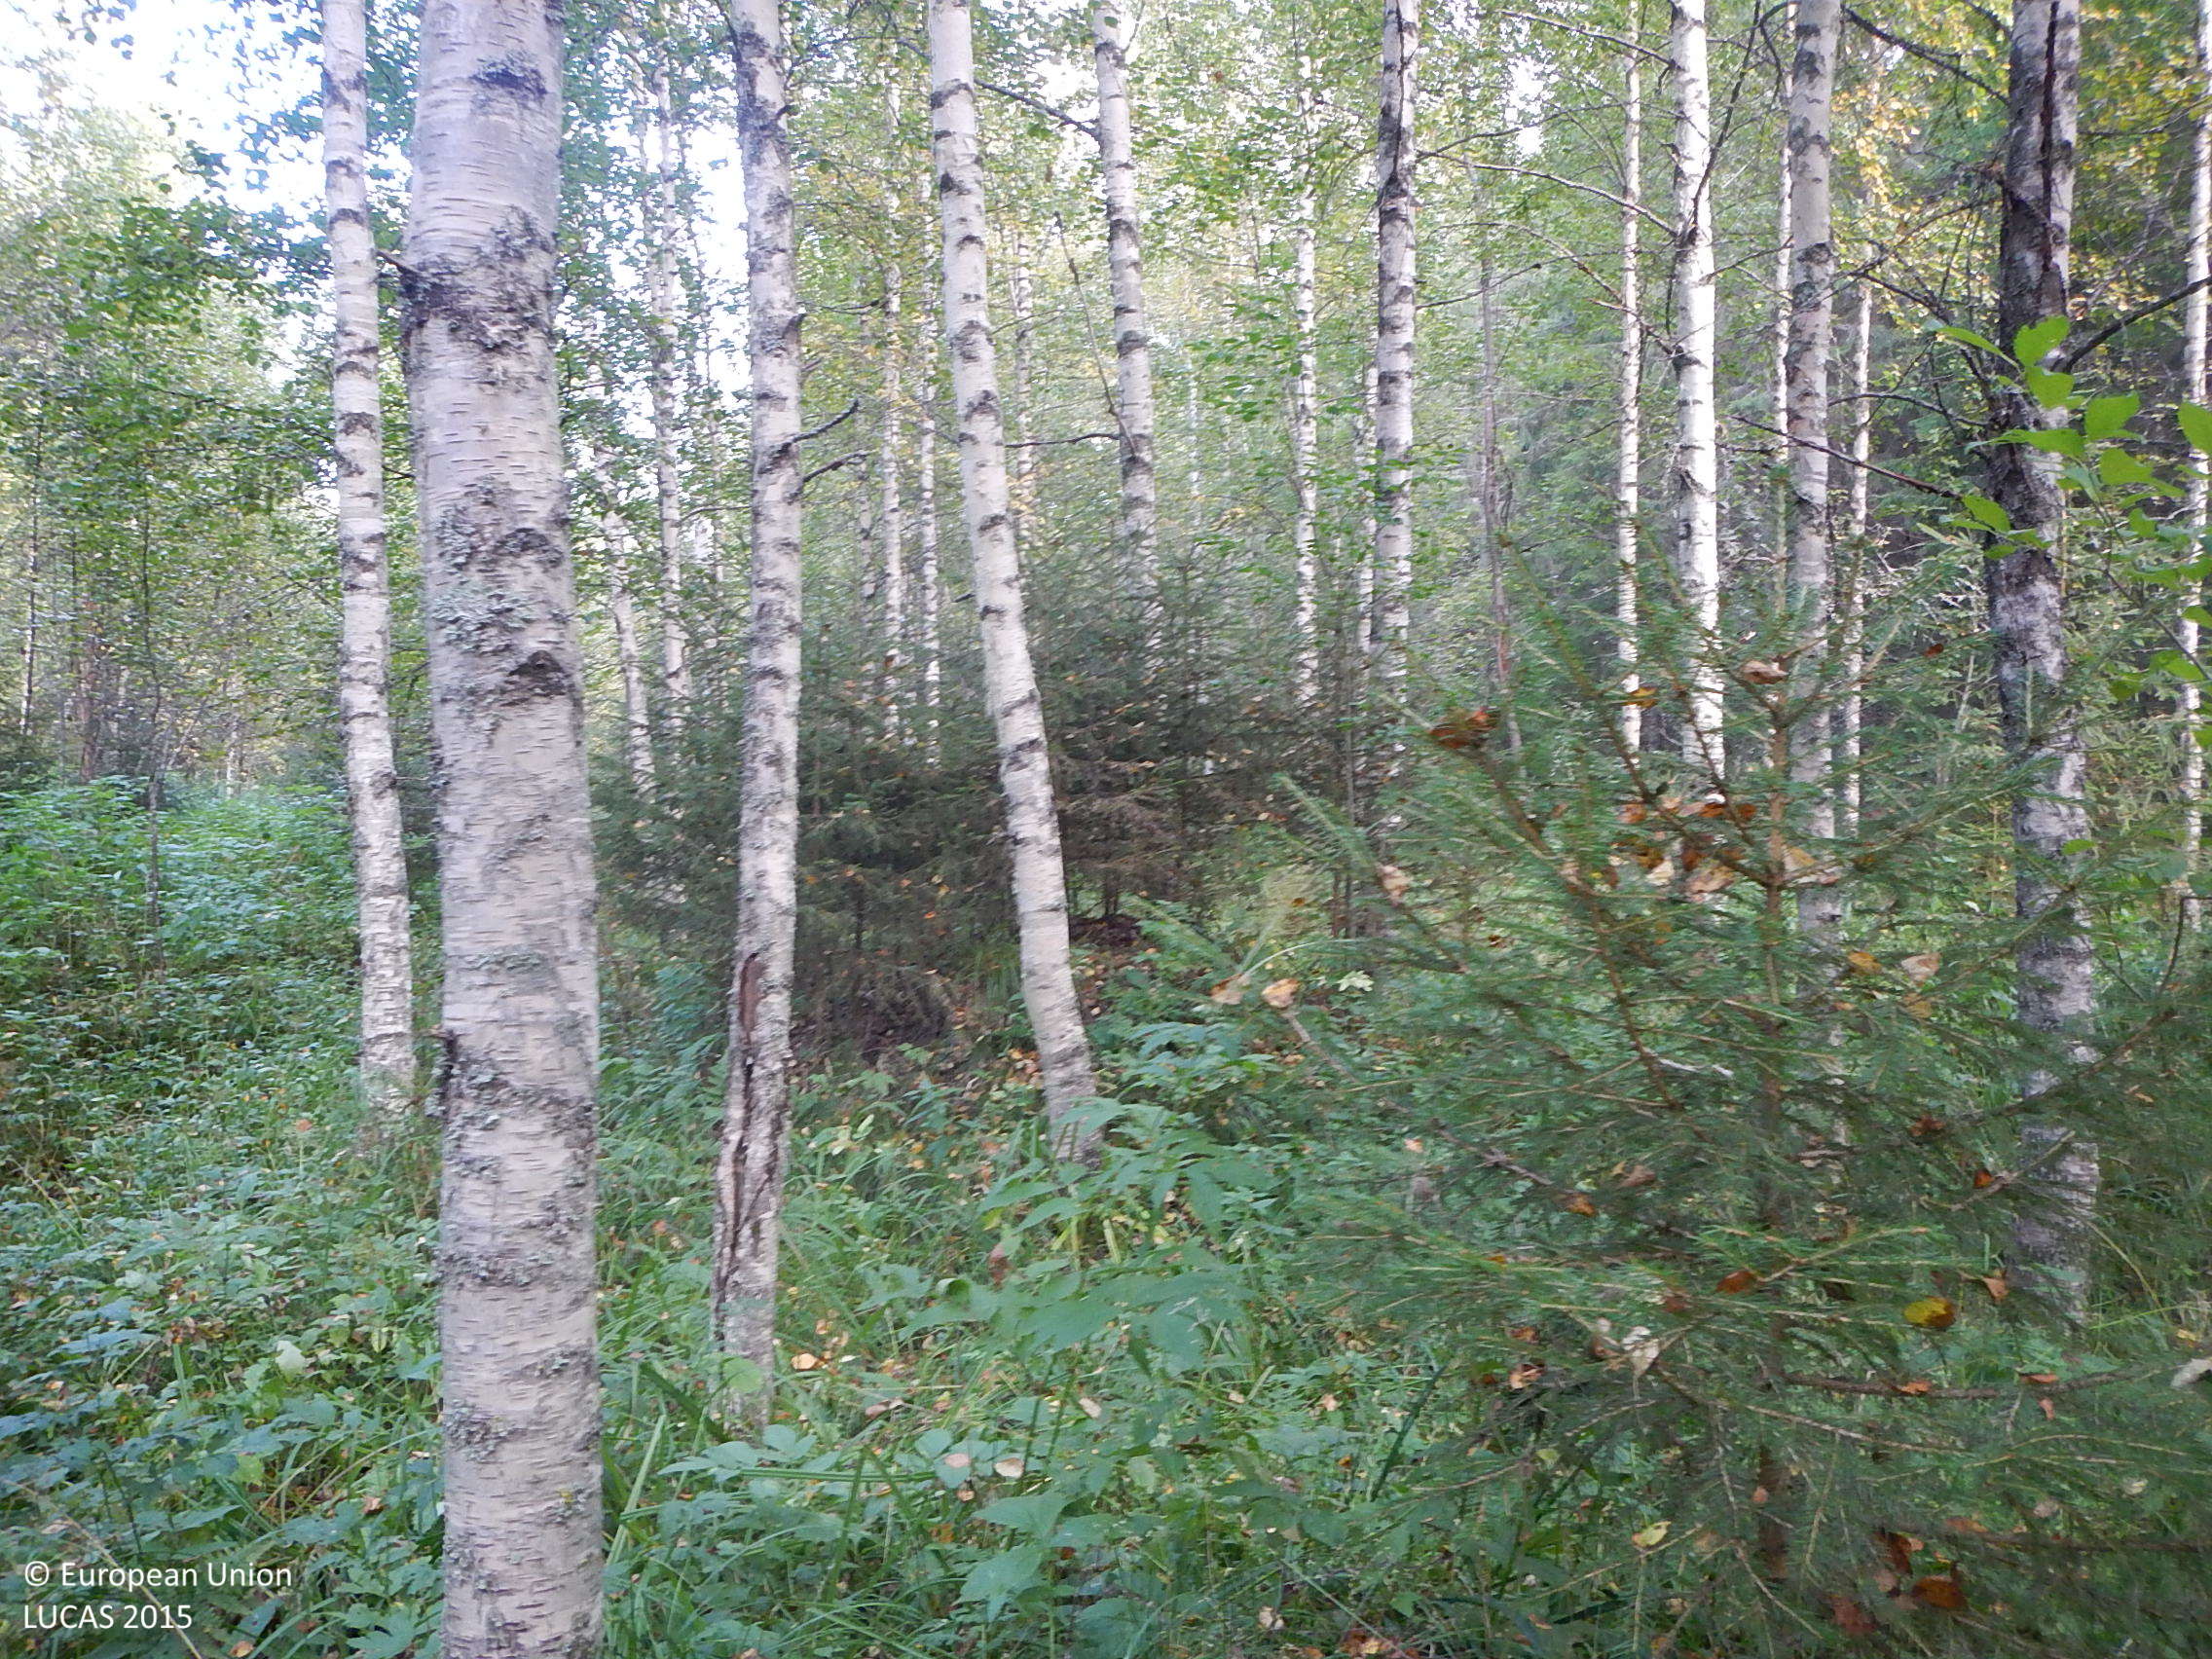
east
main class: Woodland
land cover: Broadleaved woodland
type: non-riverine alder, birch or aspen forest
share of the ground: > 75 %
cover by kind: broadleaved forest trees 75 %, herbaceous plants 20 %, shrubs 5 %
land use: Forestry
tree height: > 5 m
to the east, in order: Broadleaved woodland; Ditches and canals; Broadleaved woodland; Ditches and canals; Spruce dominated mixed woodland; Ditches and canals; Tracks; Ditches and canals; Spruce dominated mixed woodland
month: September
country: FI
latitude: 61.4657
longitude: 22.0870
